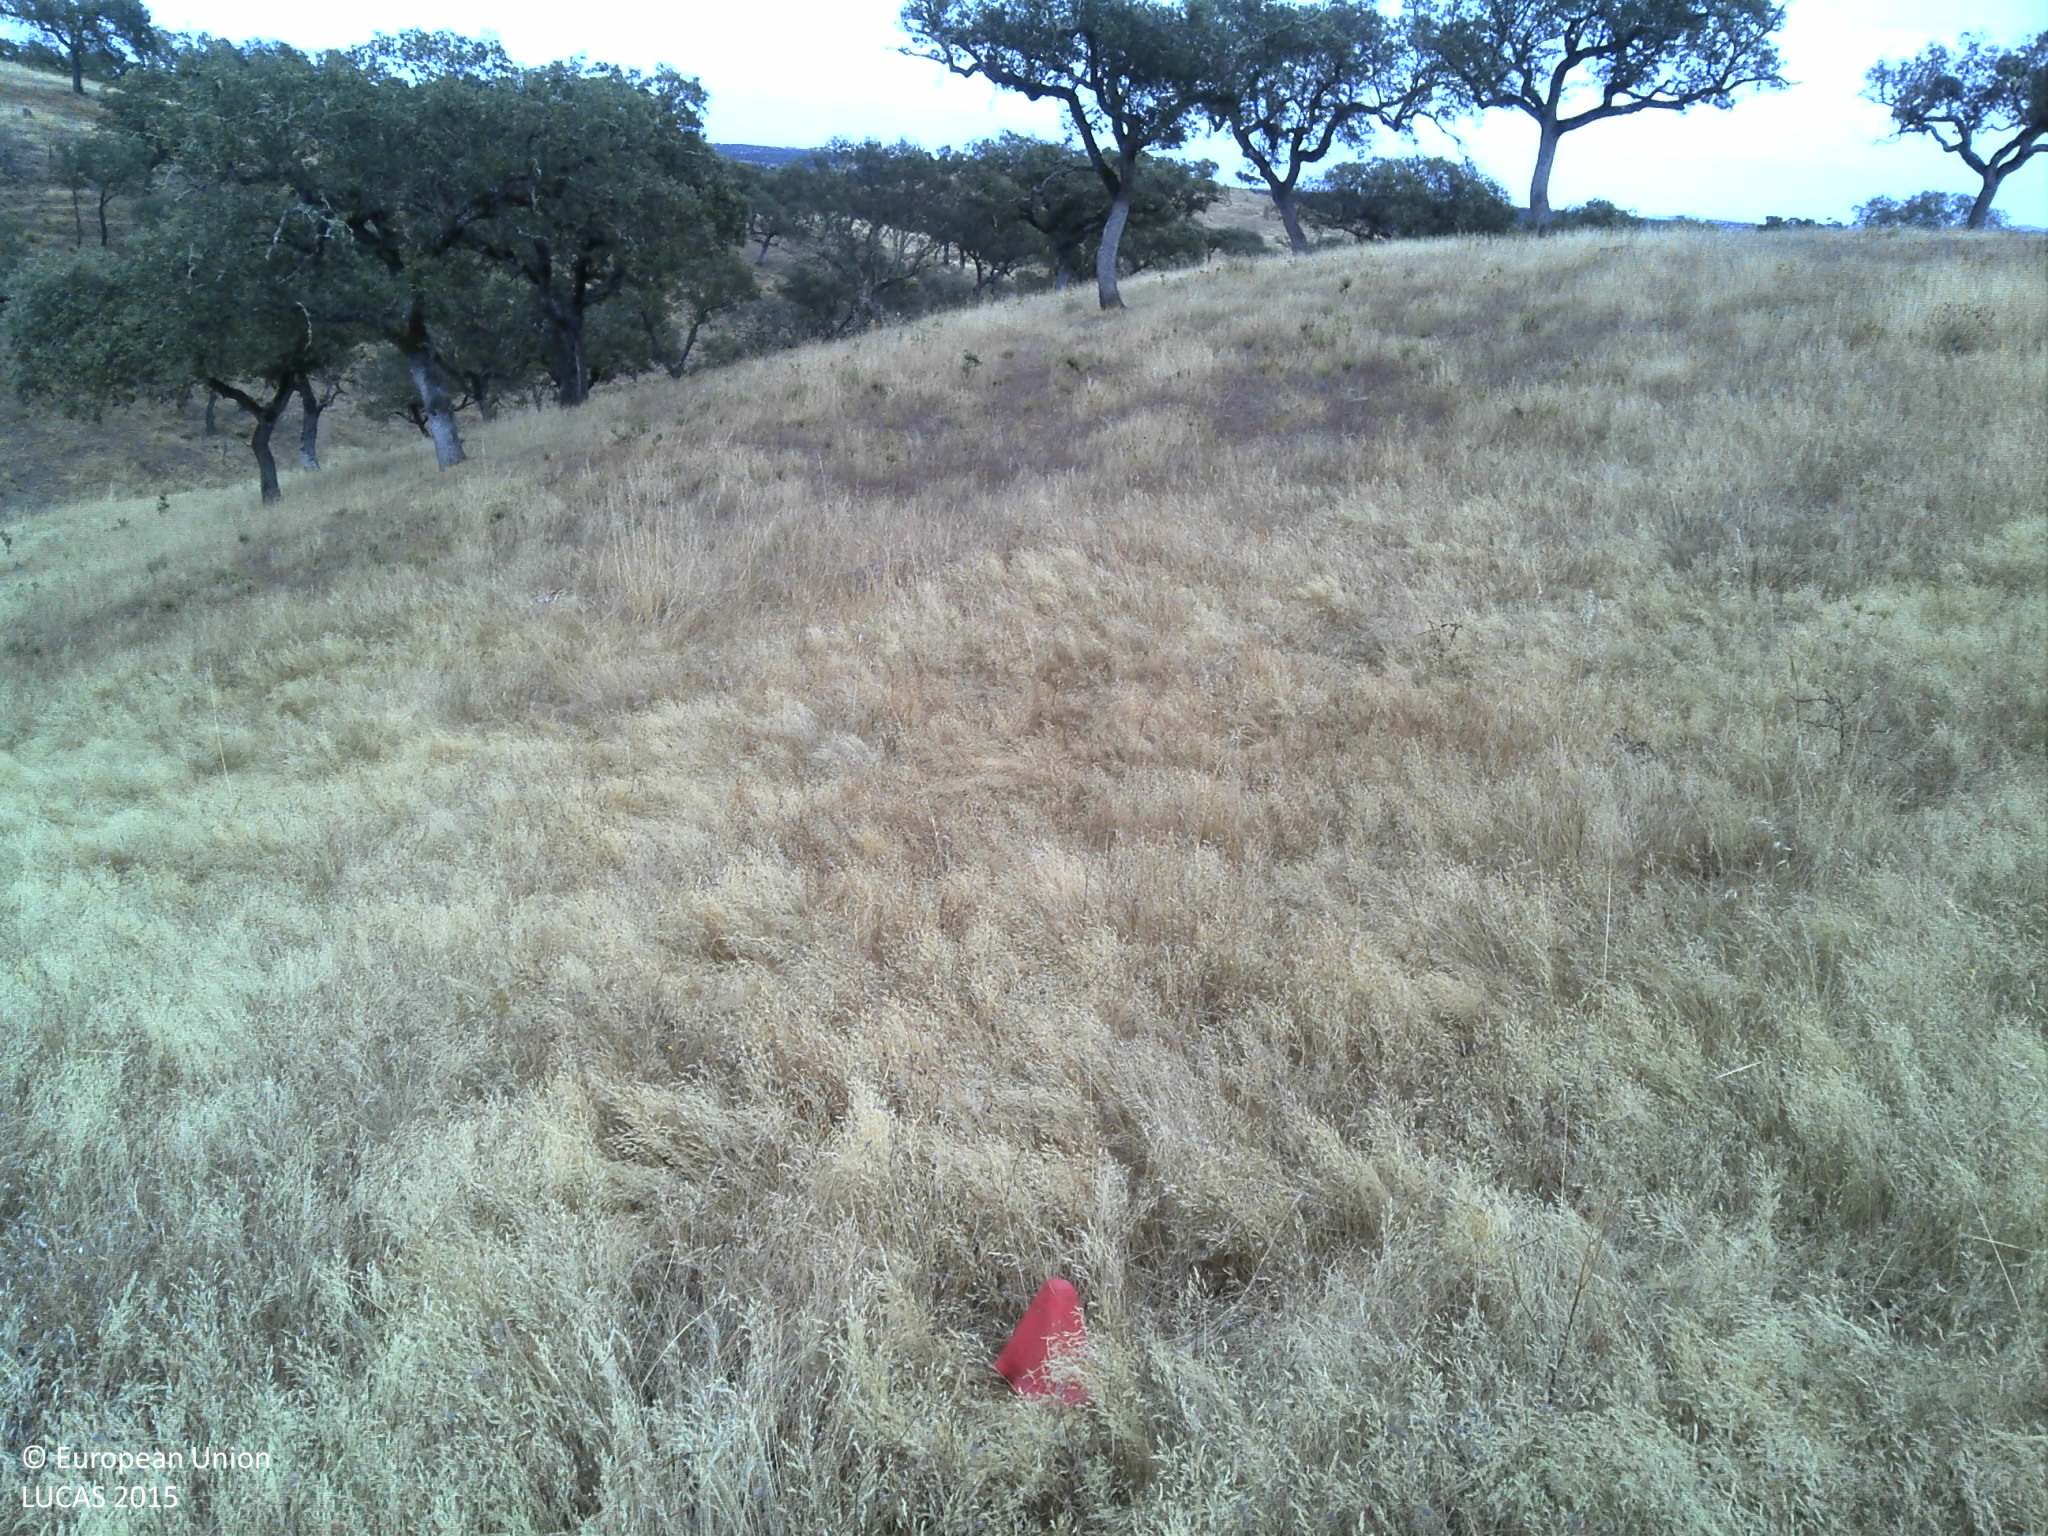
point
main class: Woodland
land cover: Broadleaved woodland
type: broadleaved evergreen forest
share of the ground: 10 - 25 %
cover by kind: unconsolidated bare surface 45 %, broadleaved forest trees 25 %, herbaceous plants 25 %
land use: Forestry
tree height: > 5 m
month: July
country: PT
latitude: 38.1277
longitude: -7.0902
